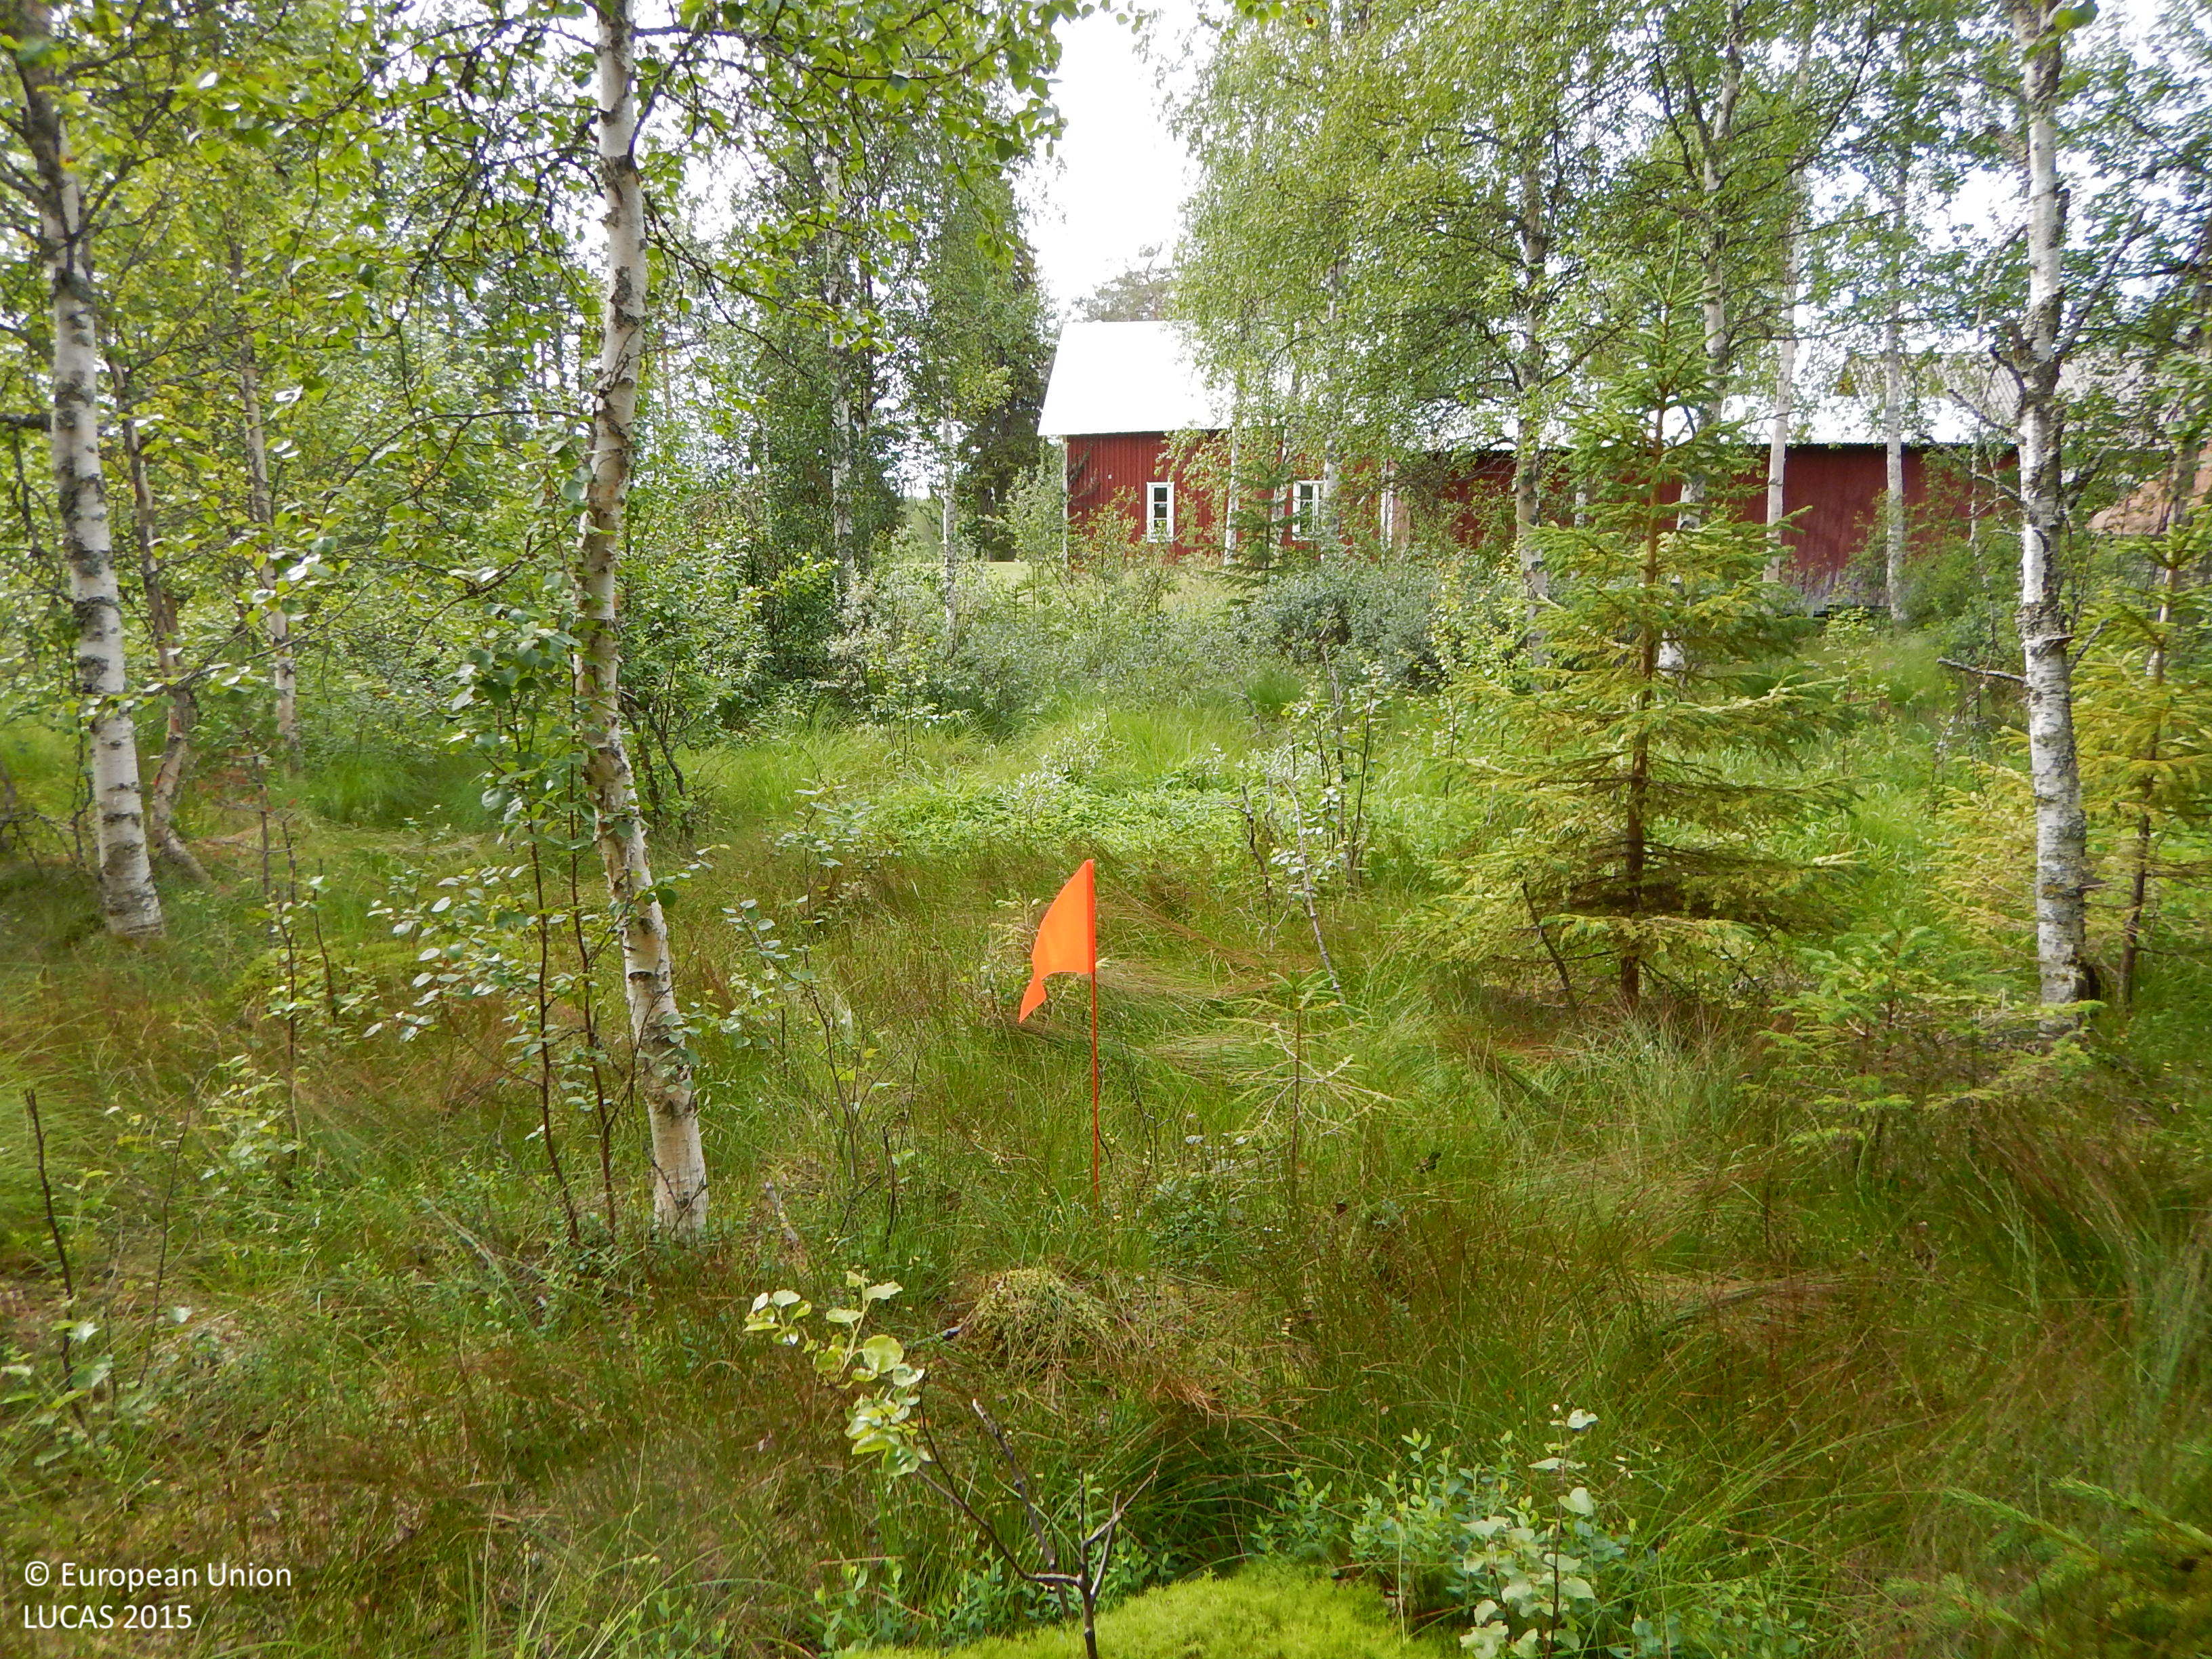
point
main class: Woodland
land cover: Broadleaved woodland
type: boreal forest
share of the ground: 50 - 75 %
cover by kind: broadleaved forest trees 50 %, herbaceous plants 15 %, lichens and mosses 15 %, coniferous forest trees 10 %, shrubs 10 %
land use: Forestry
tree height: > 5 m
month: July
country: SE
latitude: 65.0164
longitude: 20.2195
